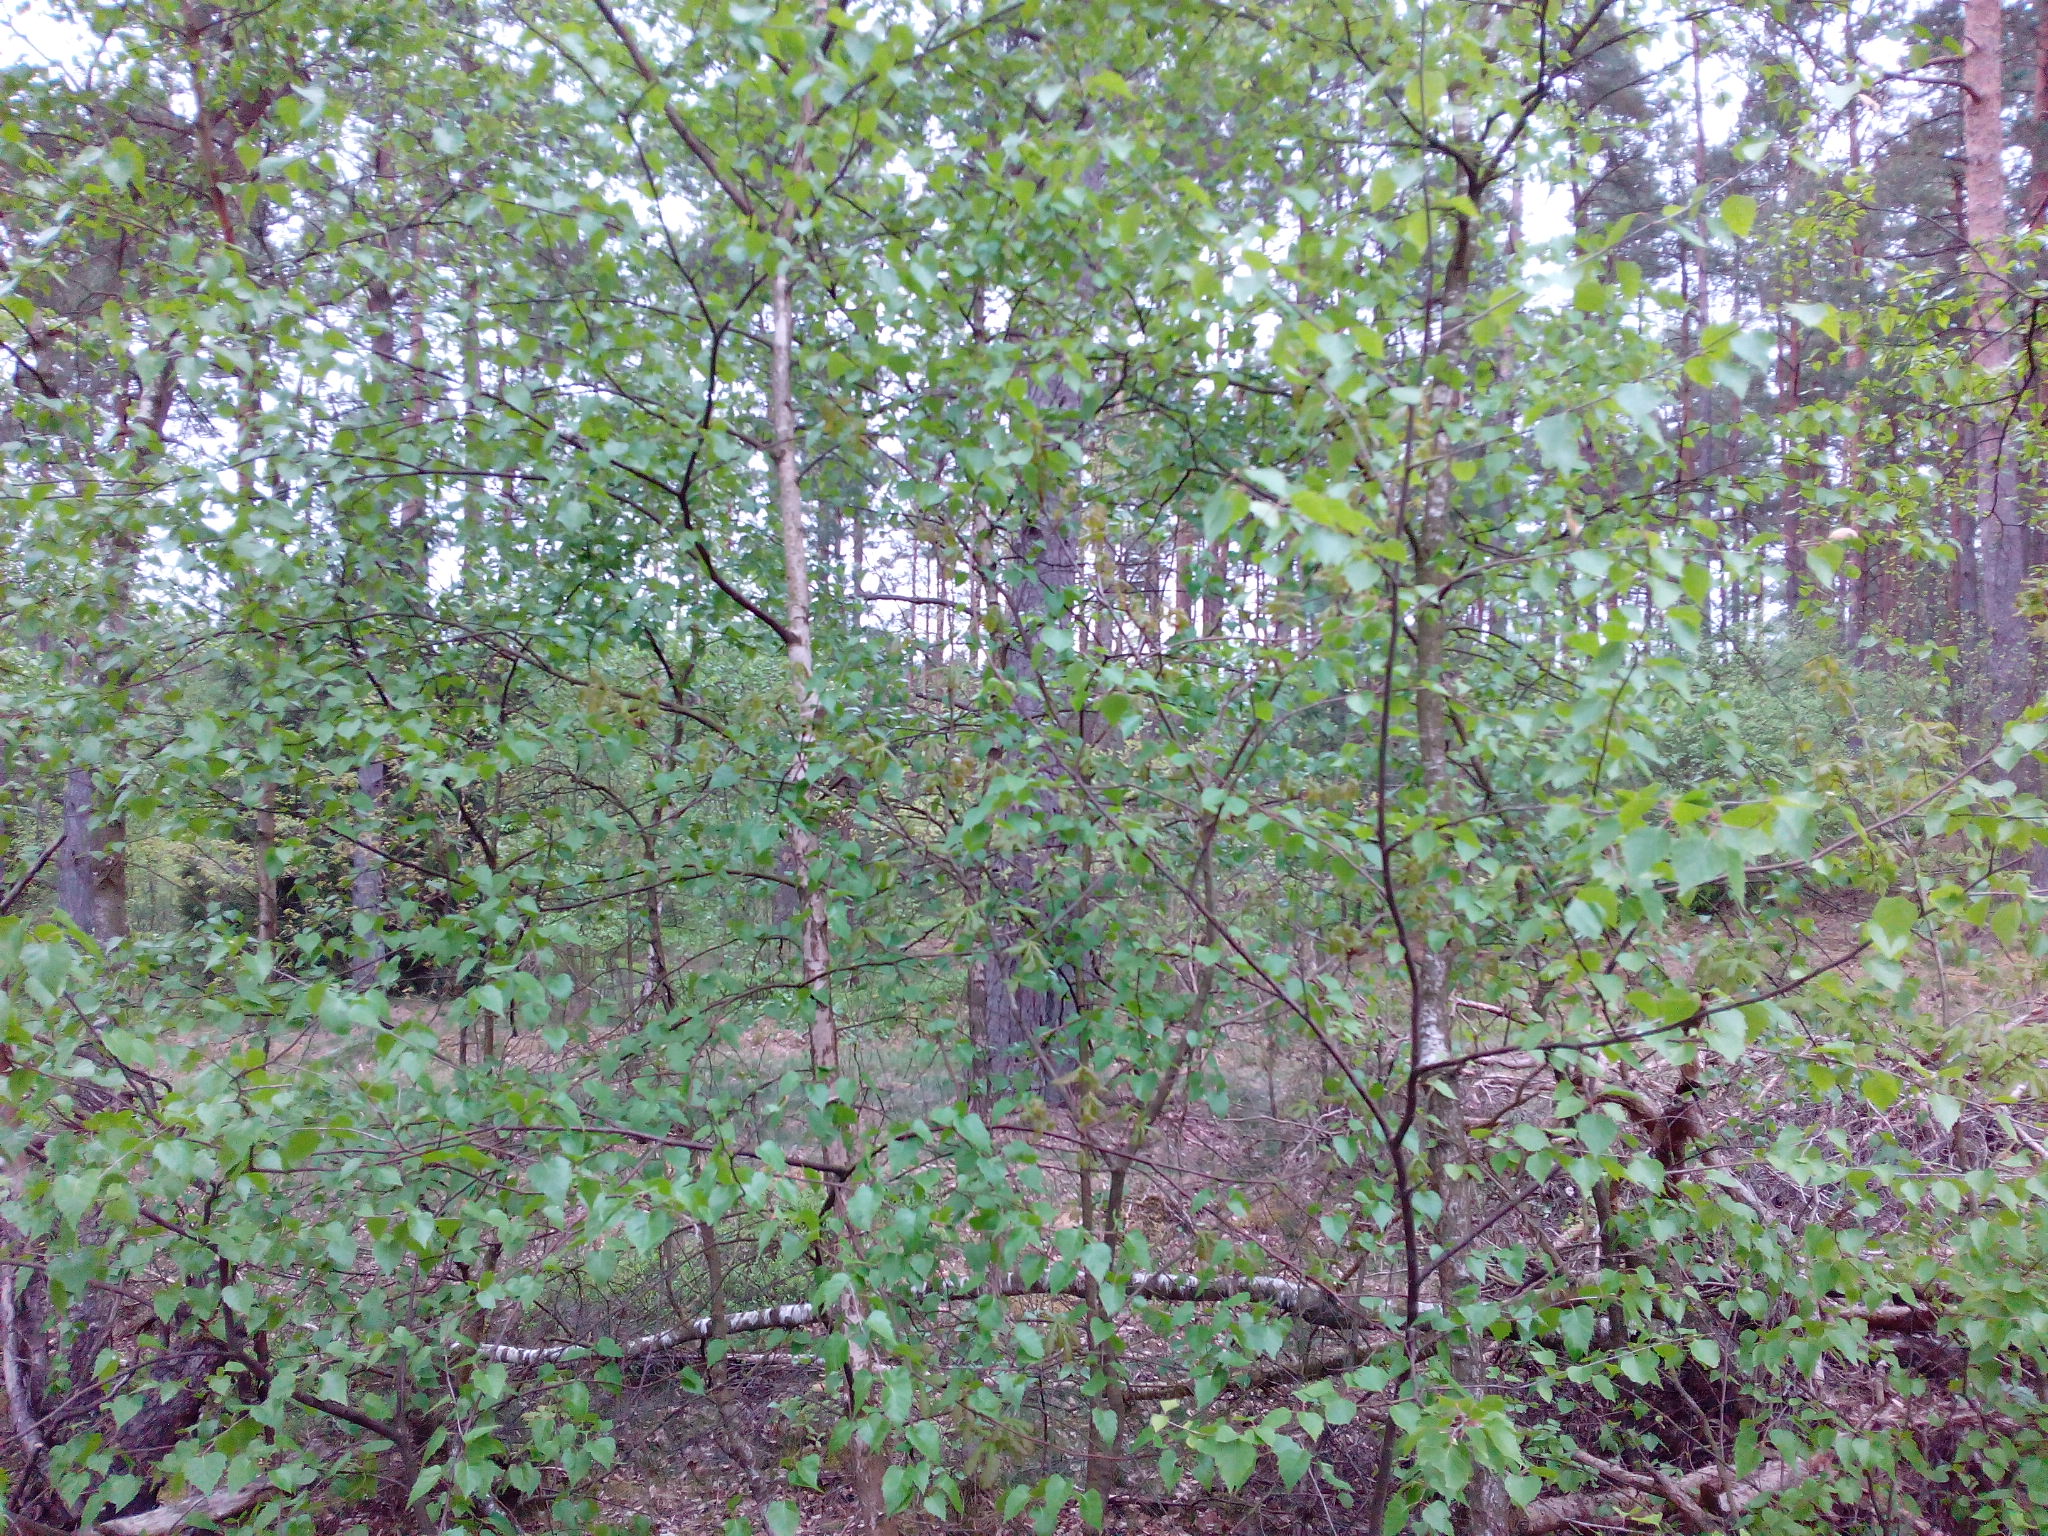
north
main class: Woodland
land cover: Pine dominated mixed woodland
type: hemiboreal forest and nemoral coniferous forest and mixed broadleaved-coniferous forest
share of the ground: 50 - 75 %
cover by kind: coniferous forest trees 60 %, broadleaved forest trees 30 %, herbaceous plants 10 %
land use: Forestry
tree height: > 5 m
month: May
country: DE
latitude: 52.9706
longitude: 9.9256
